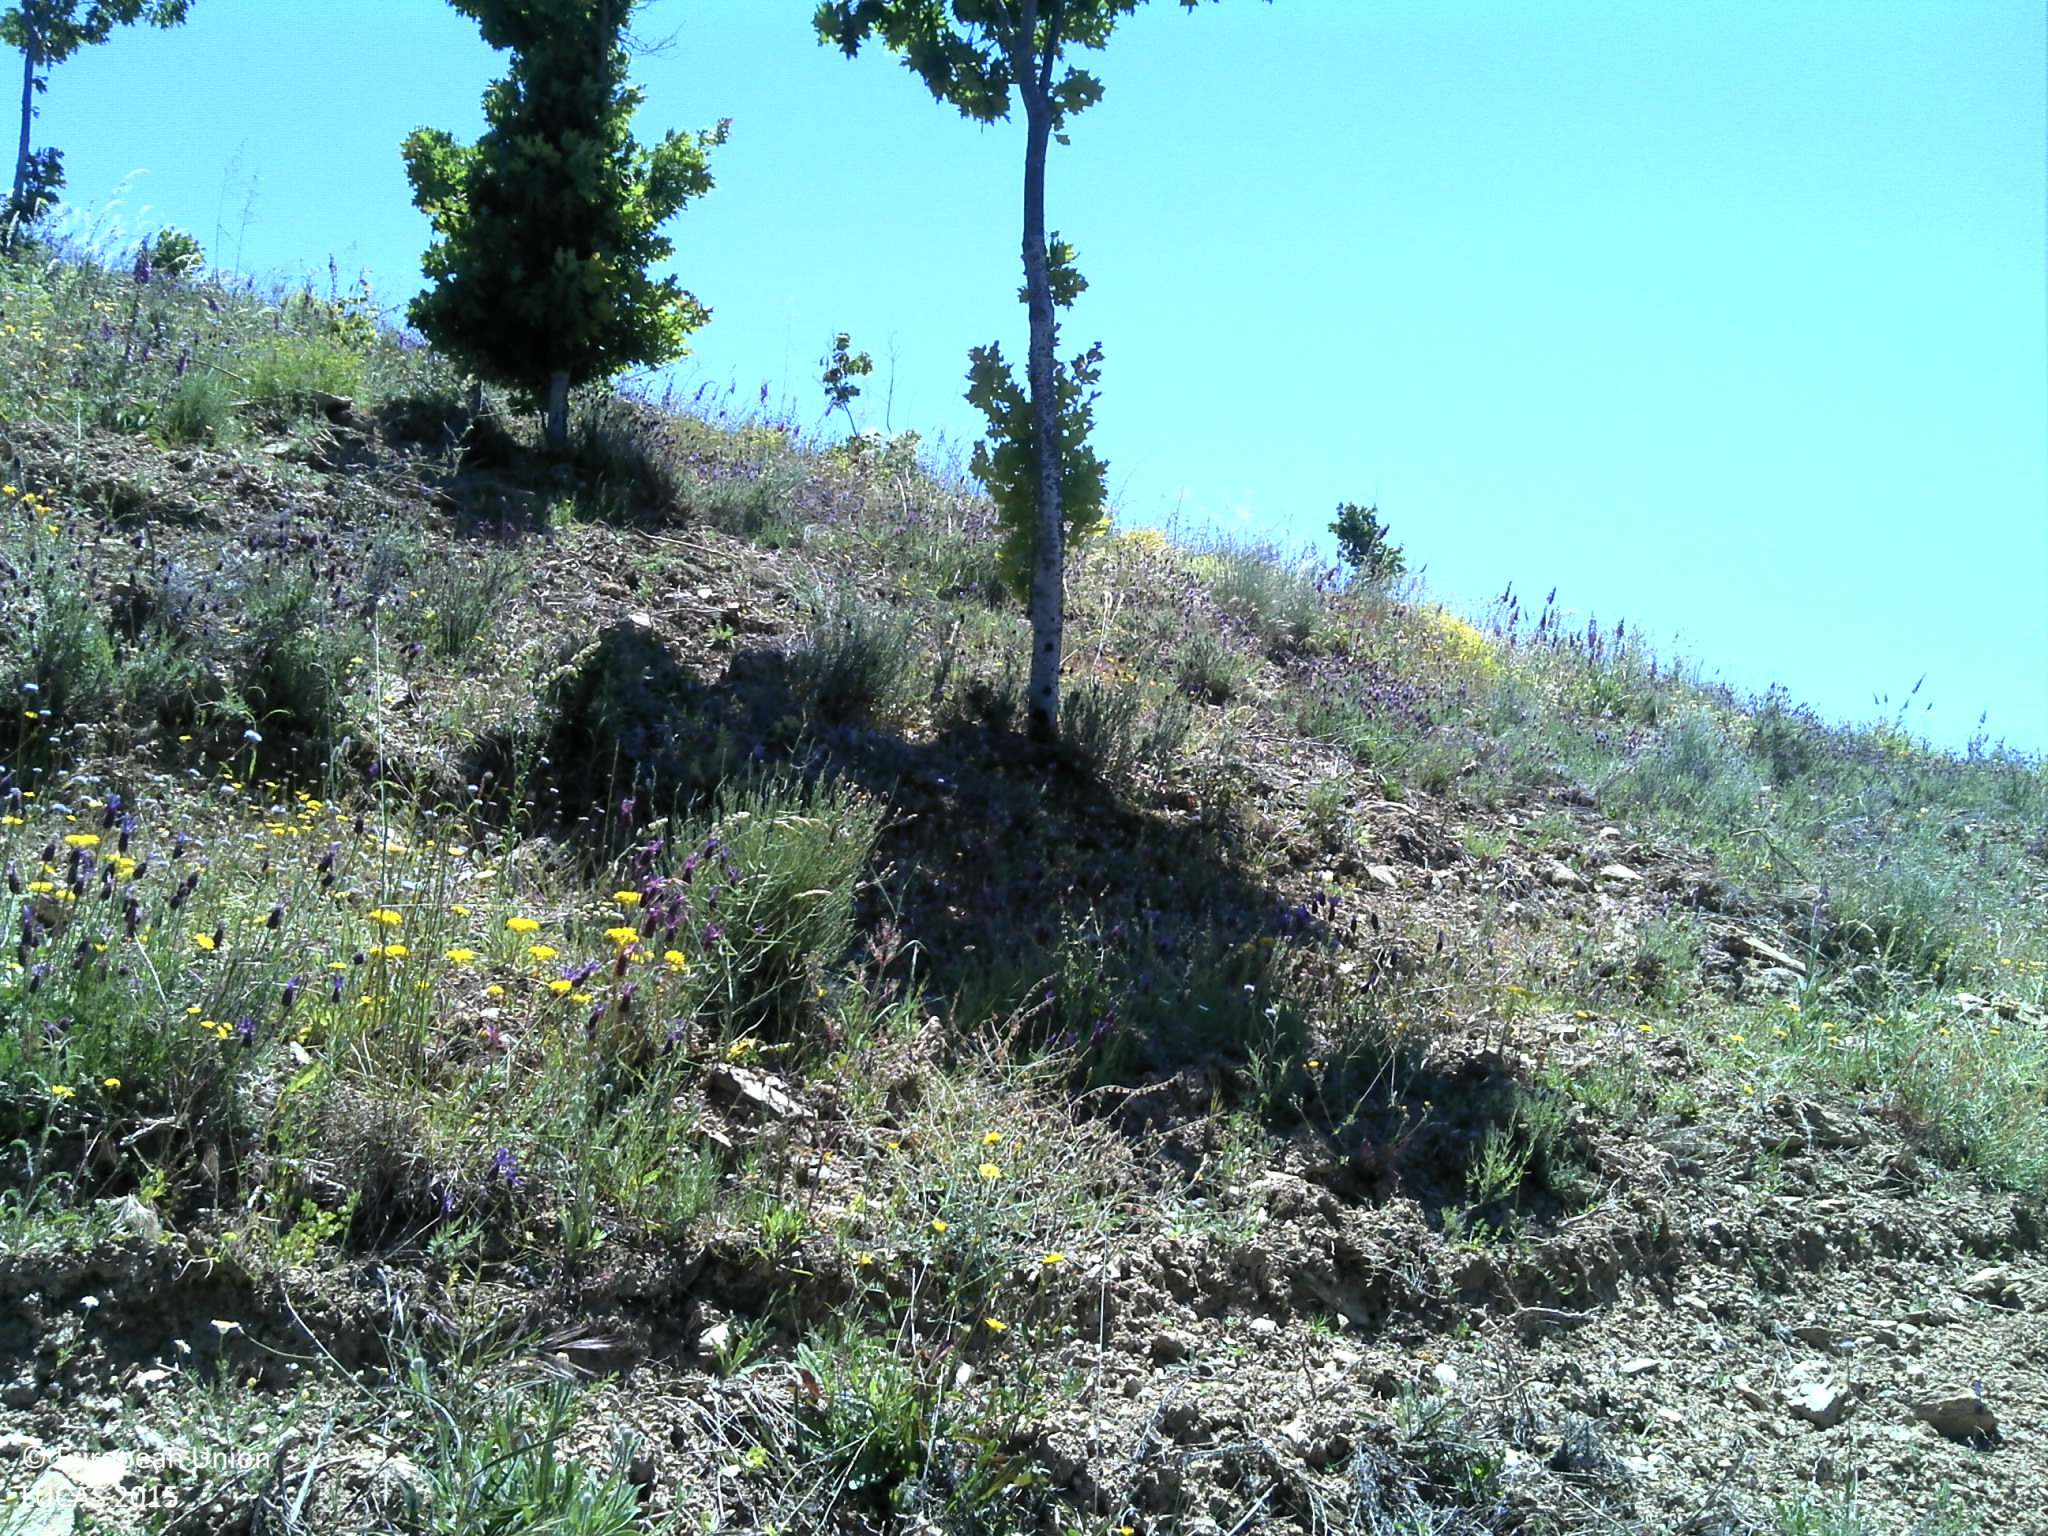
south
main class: Woodland
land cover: Broadleaved woodland
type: exotic forest
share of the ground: 10 - 25 %
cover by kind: unconsolidated bare surface 50 %, herbaceous plants 30 %, broadleaved forest trees 10 %, shrubs 10 %
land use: Forestry
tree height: > 5 m
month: May
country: PT
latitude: 41.4627
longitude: -6.5660
